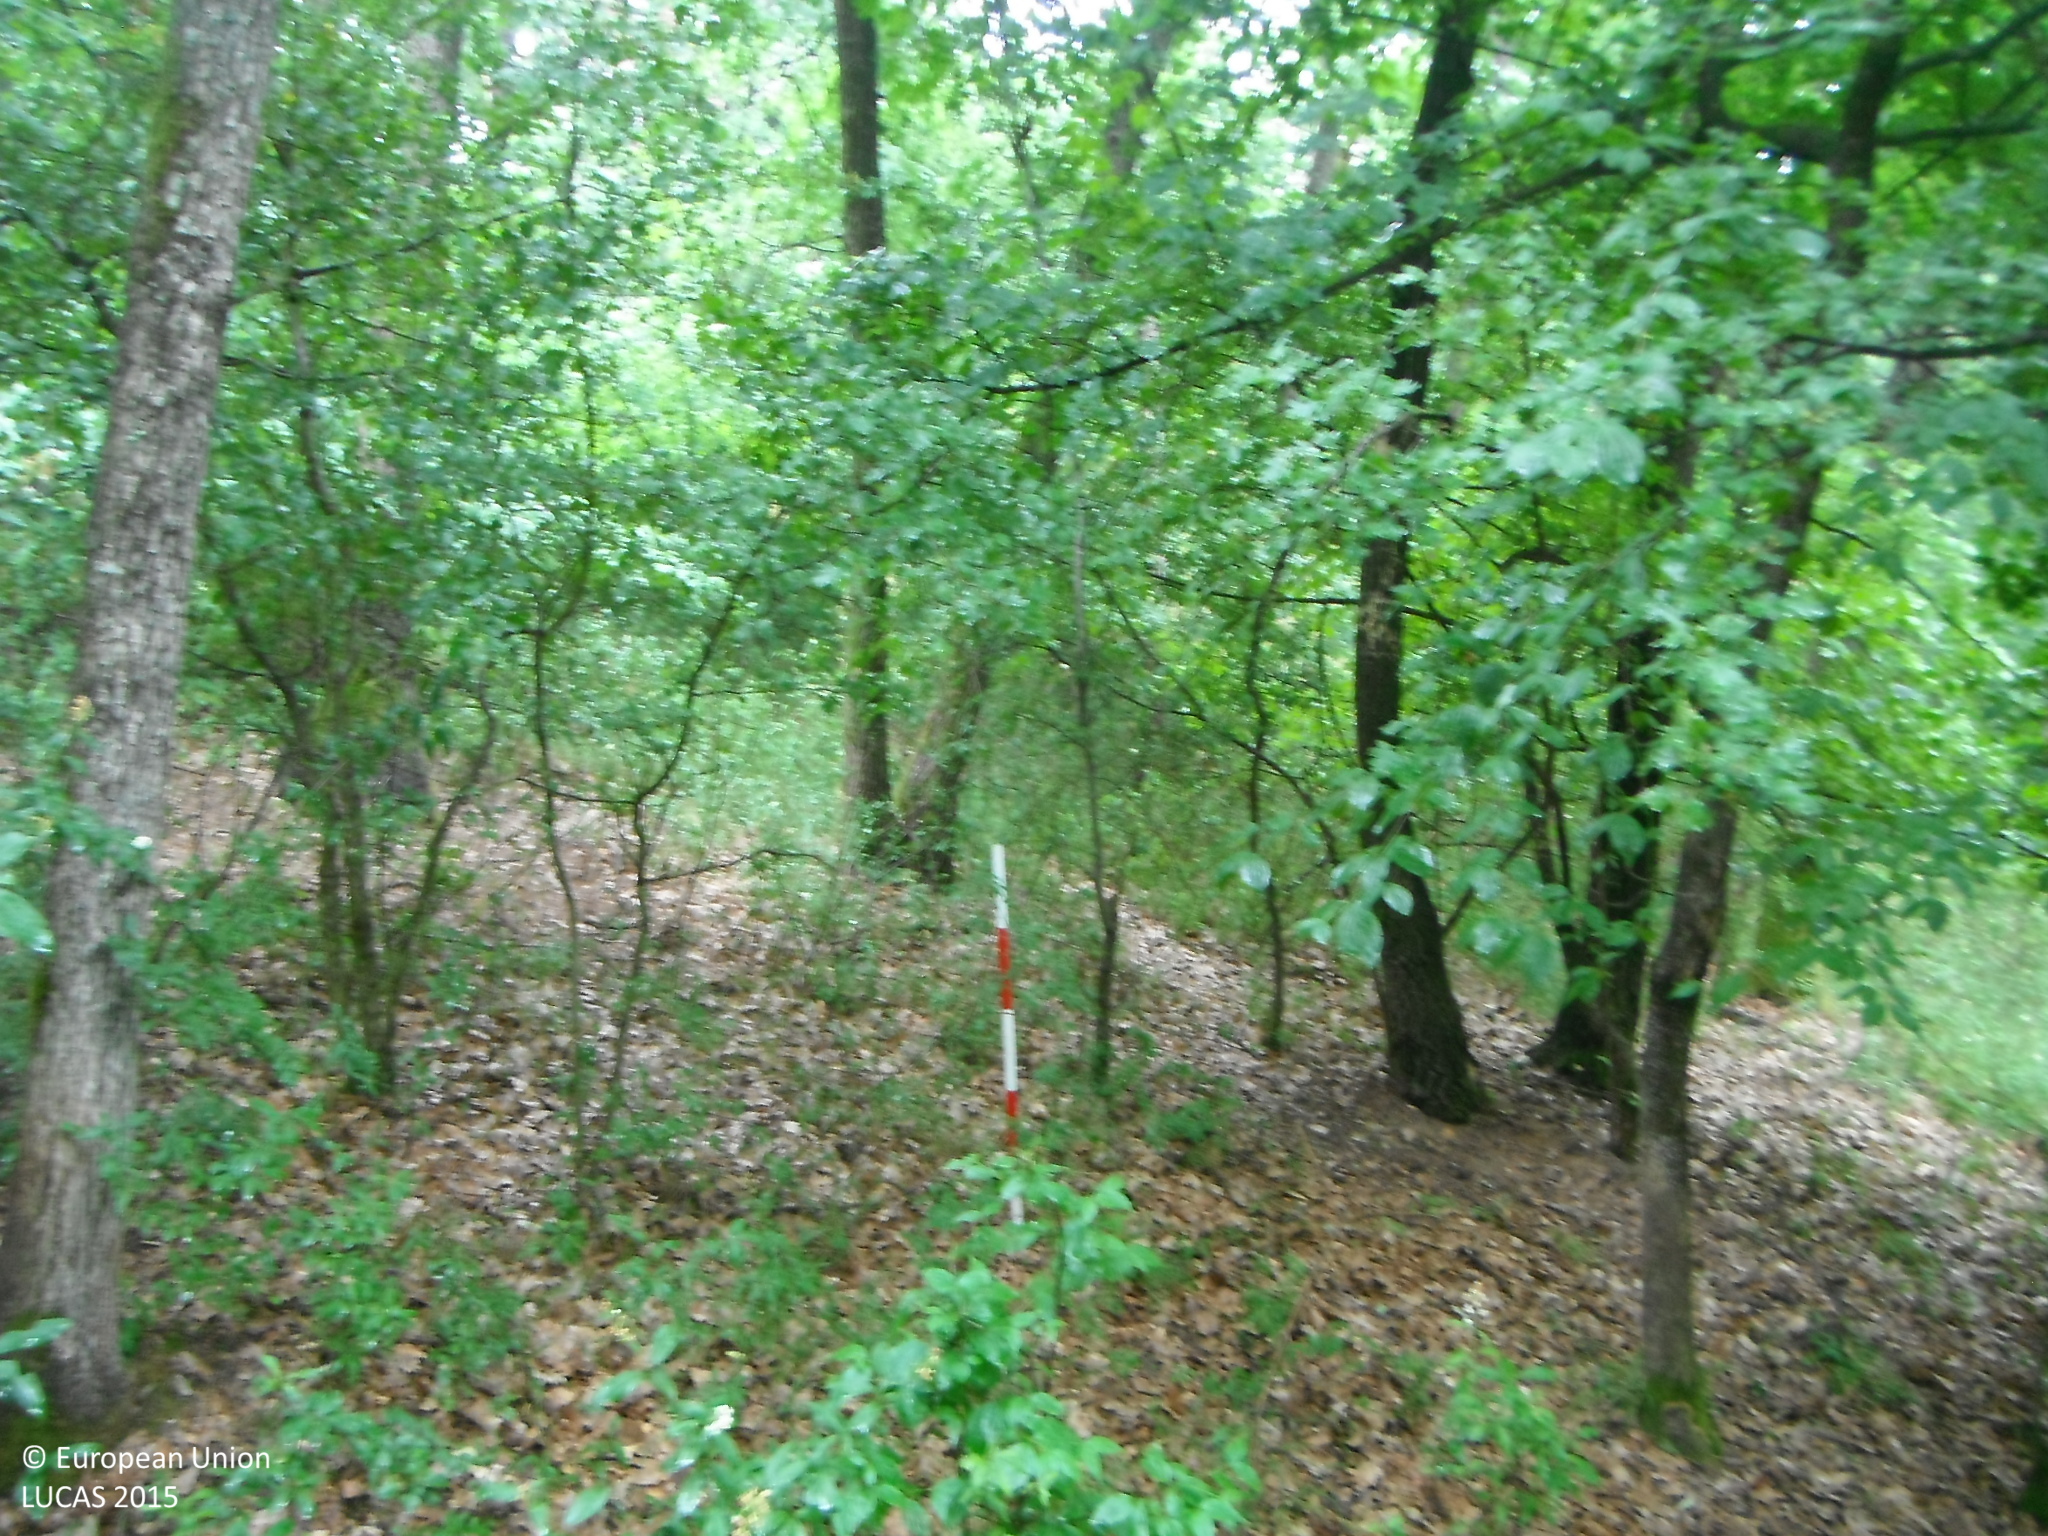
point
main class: Woodland
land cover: Broadleaved woodland
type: mesophytic deciduous forest
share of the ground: > 75 %
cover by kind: broadleaved forest trees 85 %, herbaceous plants 10 %, shrubs 5 %
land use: Forestry
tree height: > 5 m
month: June
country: SK
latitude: 48.7204
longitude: 18.3486
